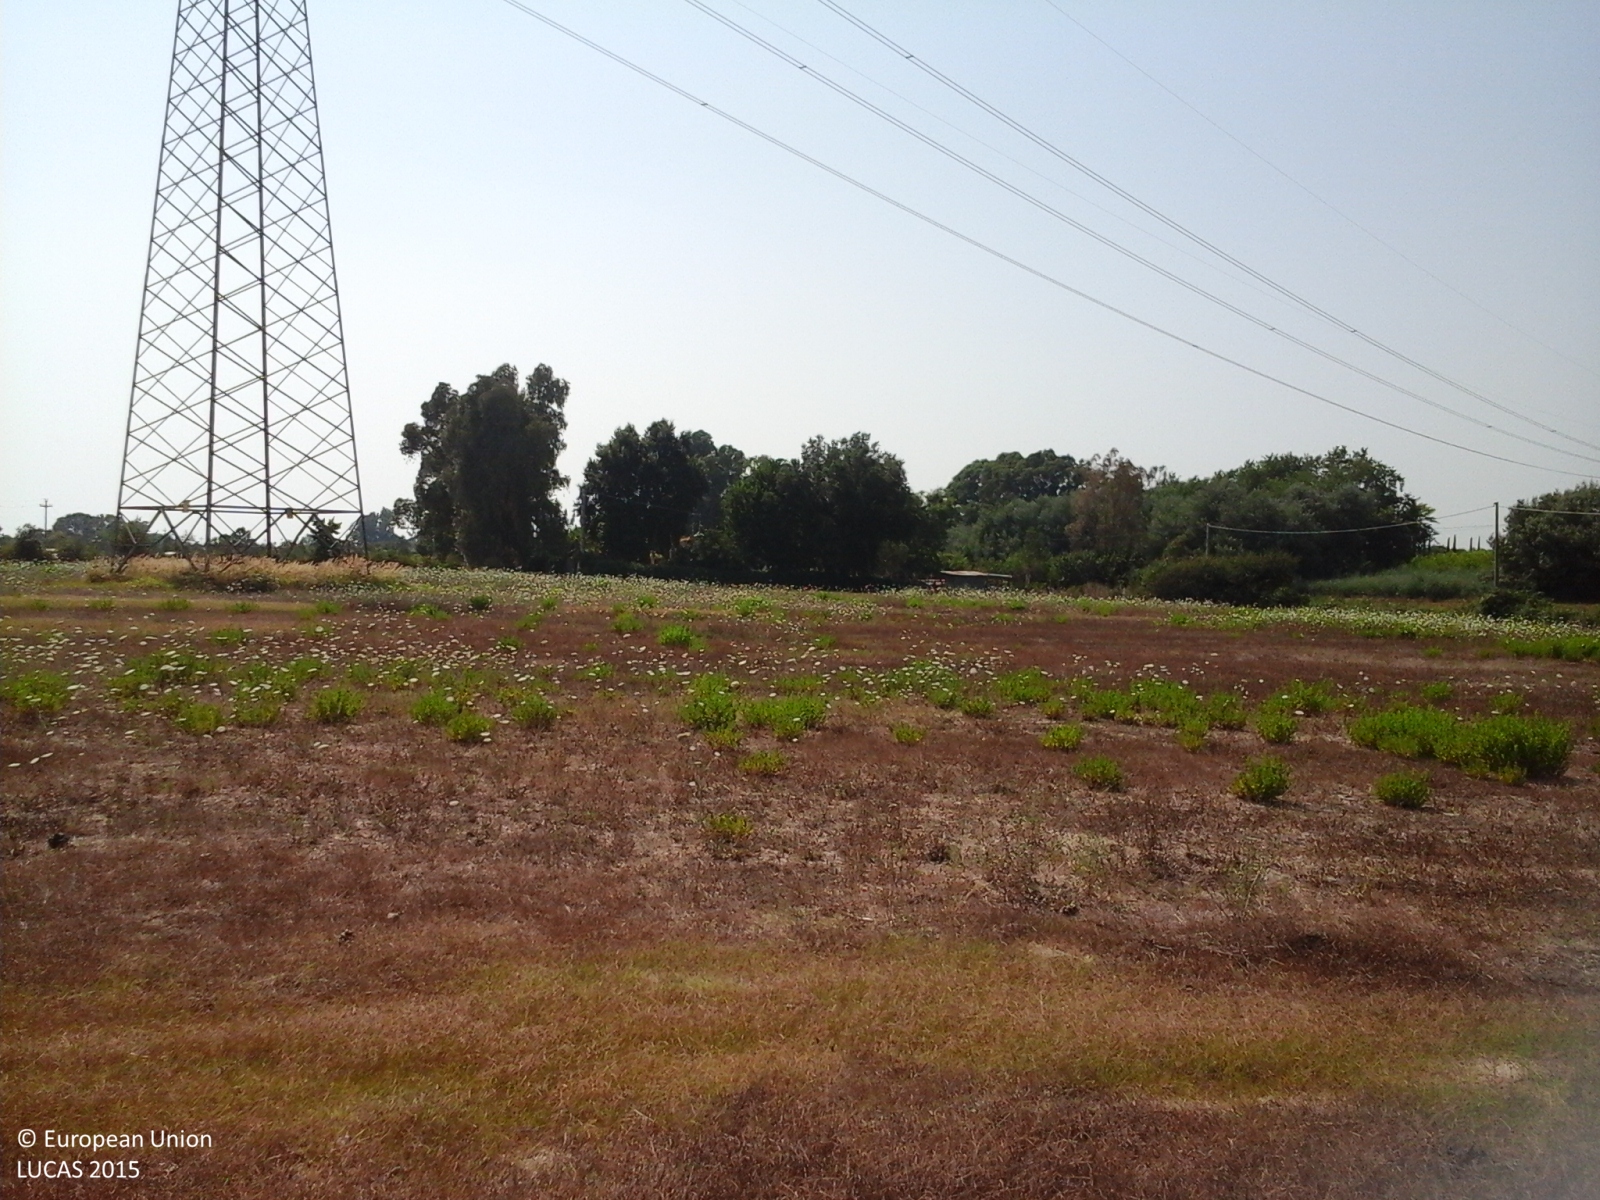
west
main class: Grassland
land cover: Grassland without tree/shrub cover
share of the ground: > 75 %
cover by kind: herbaceous plants 100 %
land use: Agriculture (excluding fallow land and kitchen gardens)
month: July
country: IT
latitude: 41.4588
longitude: 12.7783
